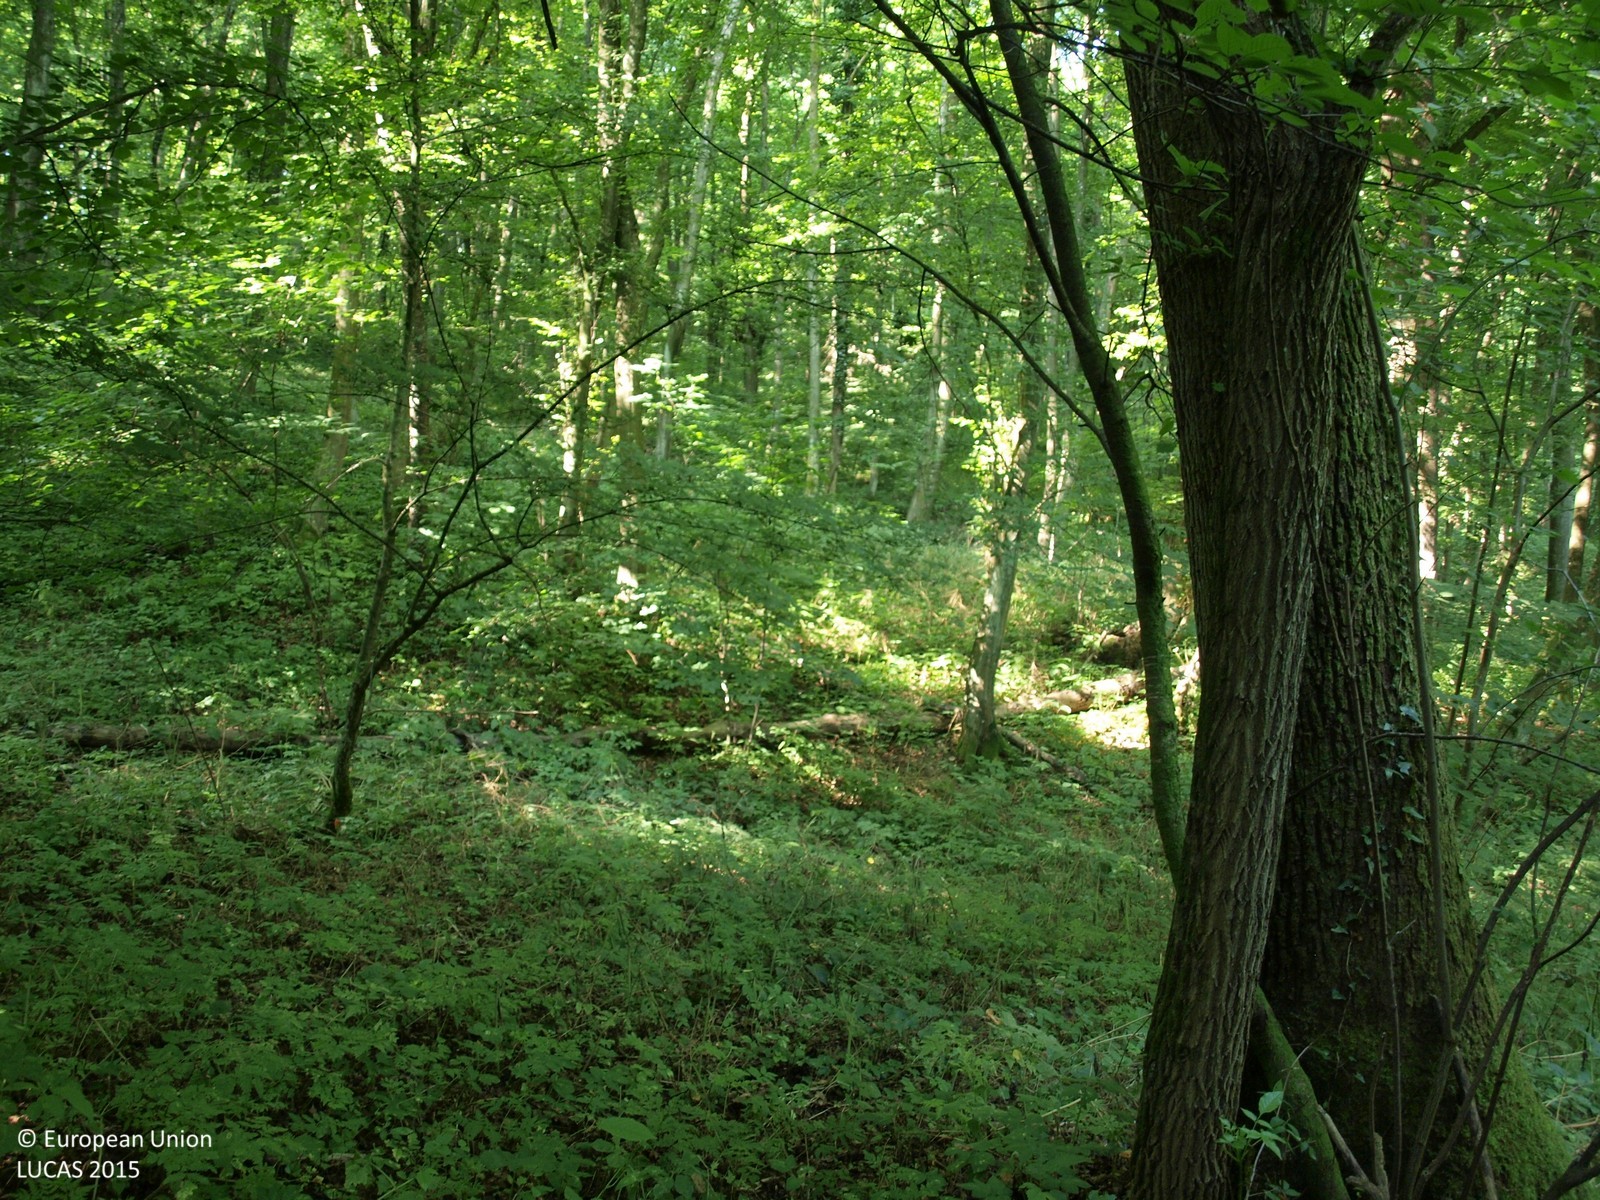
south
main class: Woodland
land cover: Broadleaved woodland
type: mesophytic deciduous forest
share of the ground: > 75 %
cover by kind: broadleaved forest trees 100 %
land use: Forestry
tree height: > 5 m
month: July
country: HR
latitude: 45.9869
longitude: 15.9495
